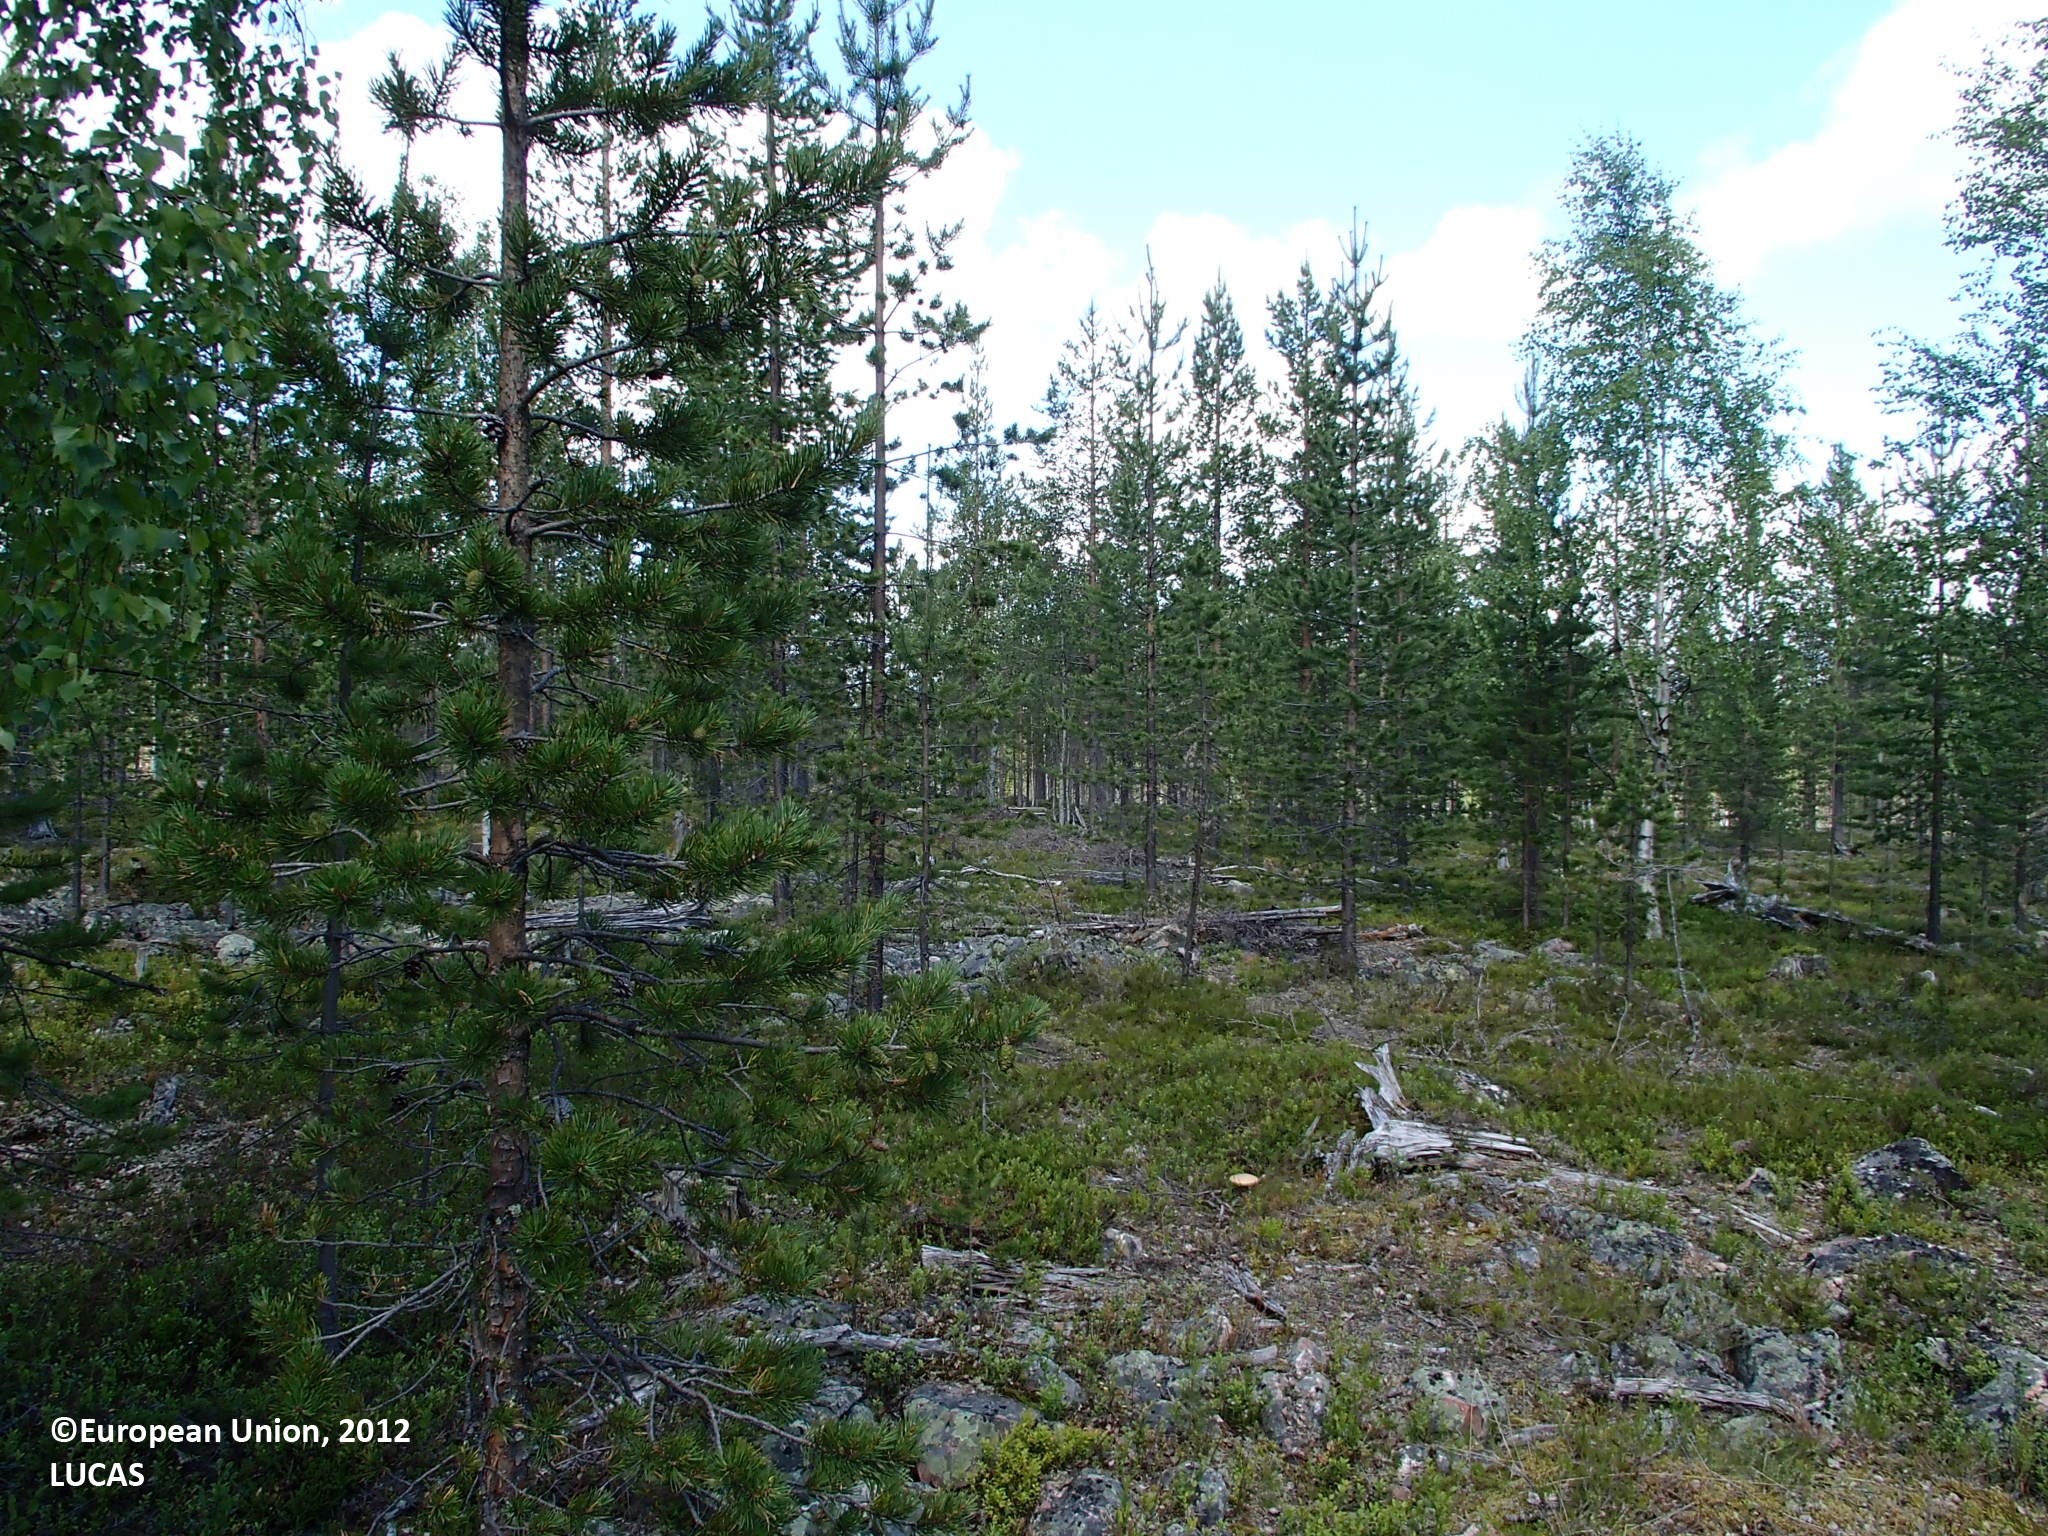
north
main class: Woodland
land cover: Pine dominated mixed woodland
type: boreal forest
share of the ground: 25 - 50 %
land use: Forestry
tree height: > 5 m
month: July
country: FI
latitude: 67.1804
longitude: 25.5592
